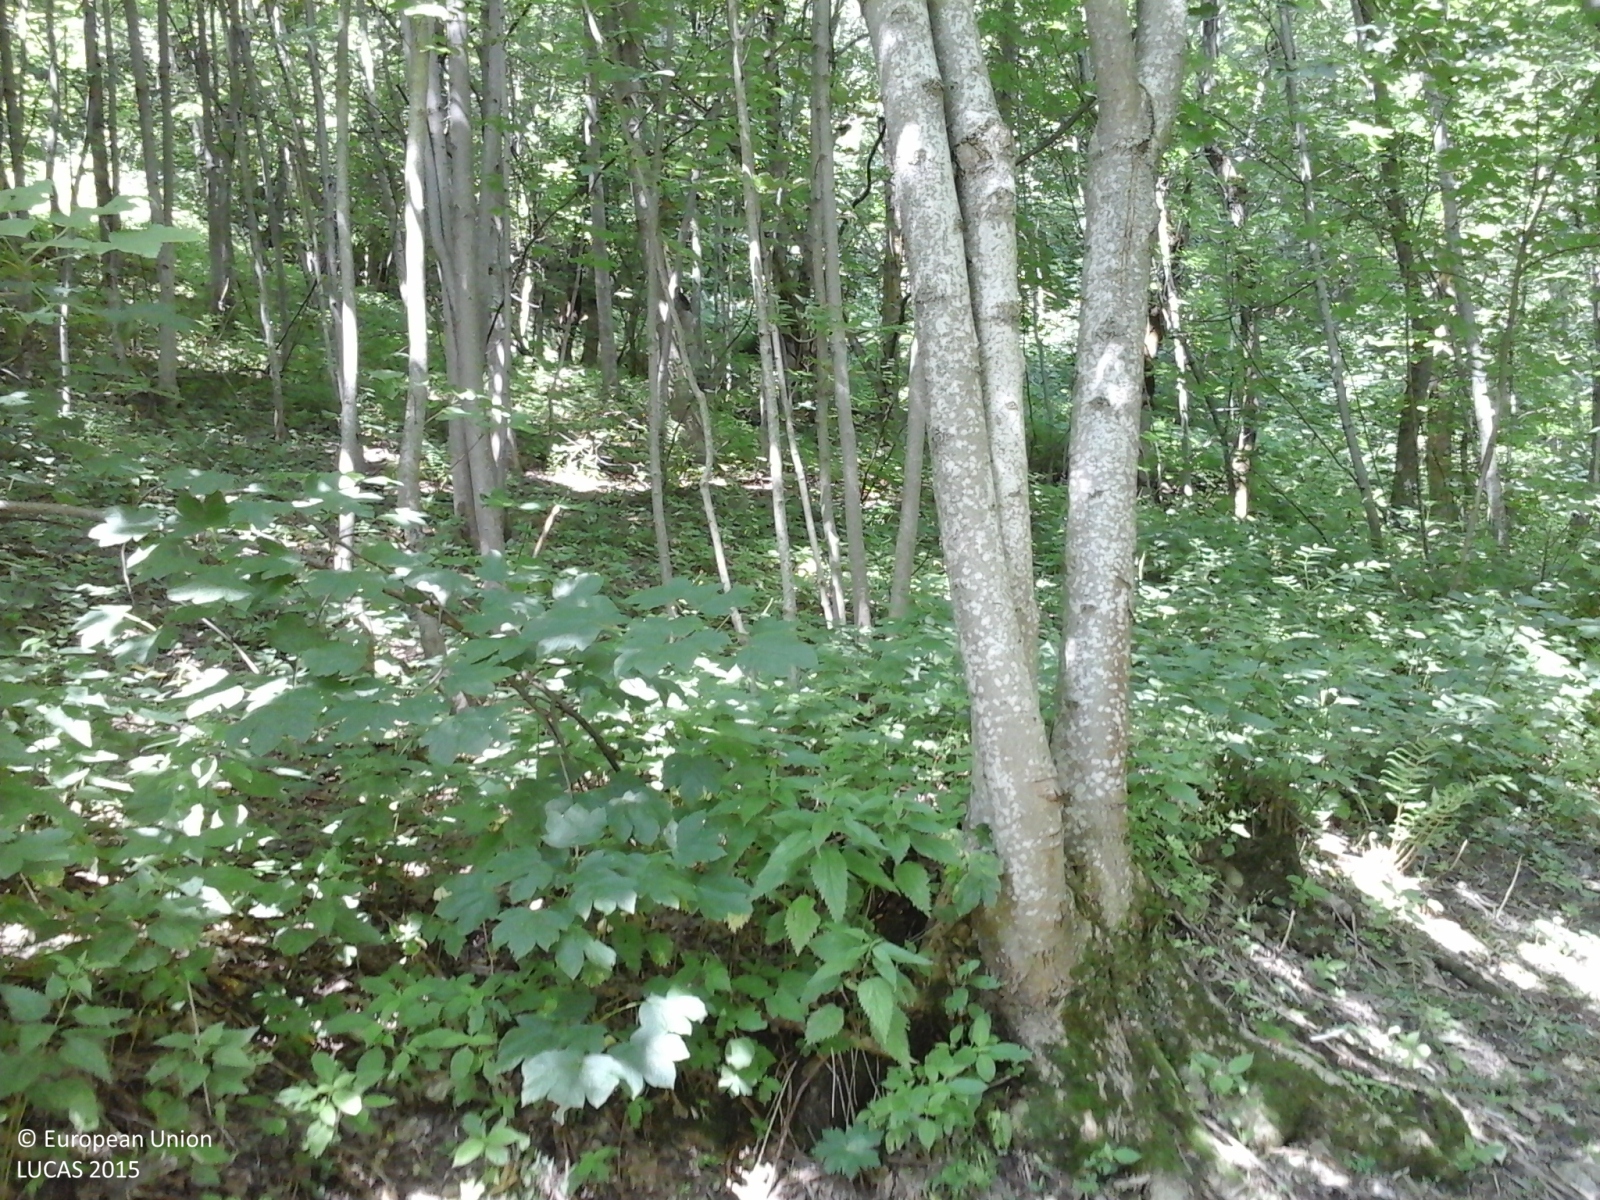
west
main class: Woodland
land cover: Broadleaved woodland
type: mountainous beech forest
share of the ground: > 75 %
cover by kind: broadleaved forest trees 100 %
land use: Forestry
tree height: > 5 m
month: July
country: IT
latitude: 44.3344
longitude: 7.3342
